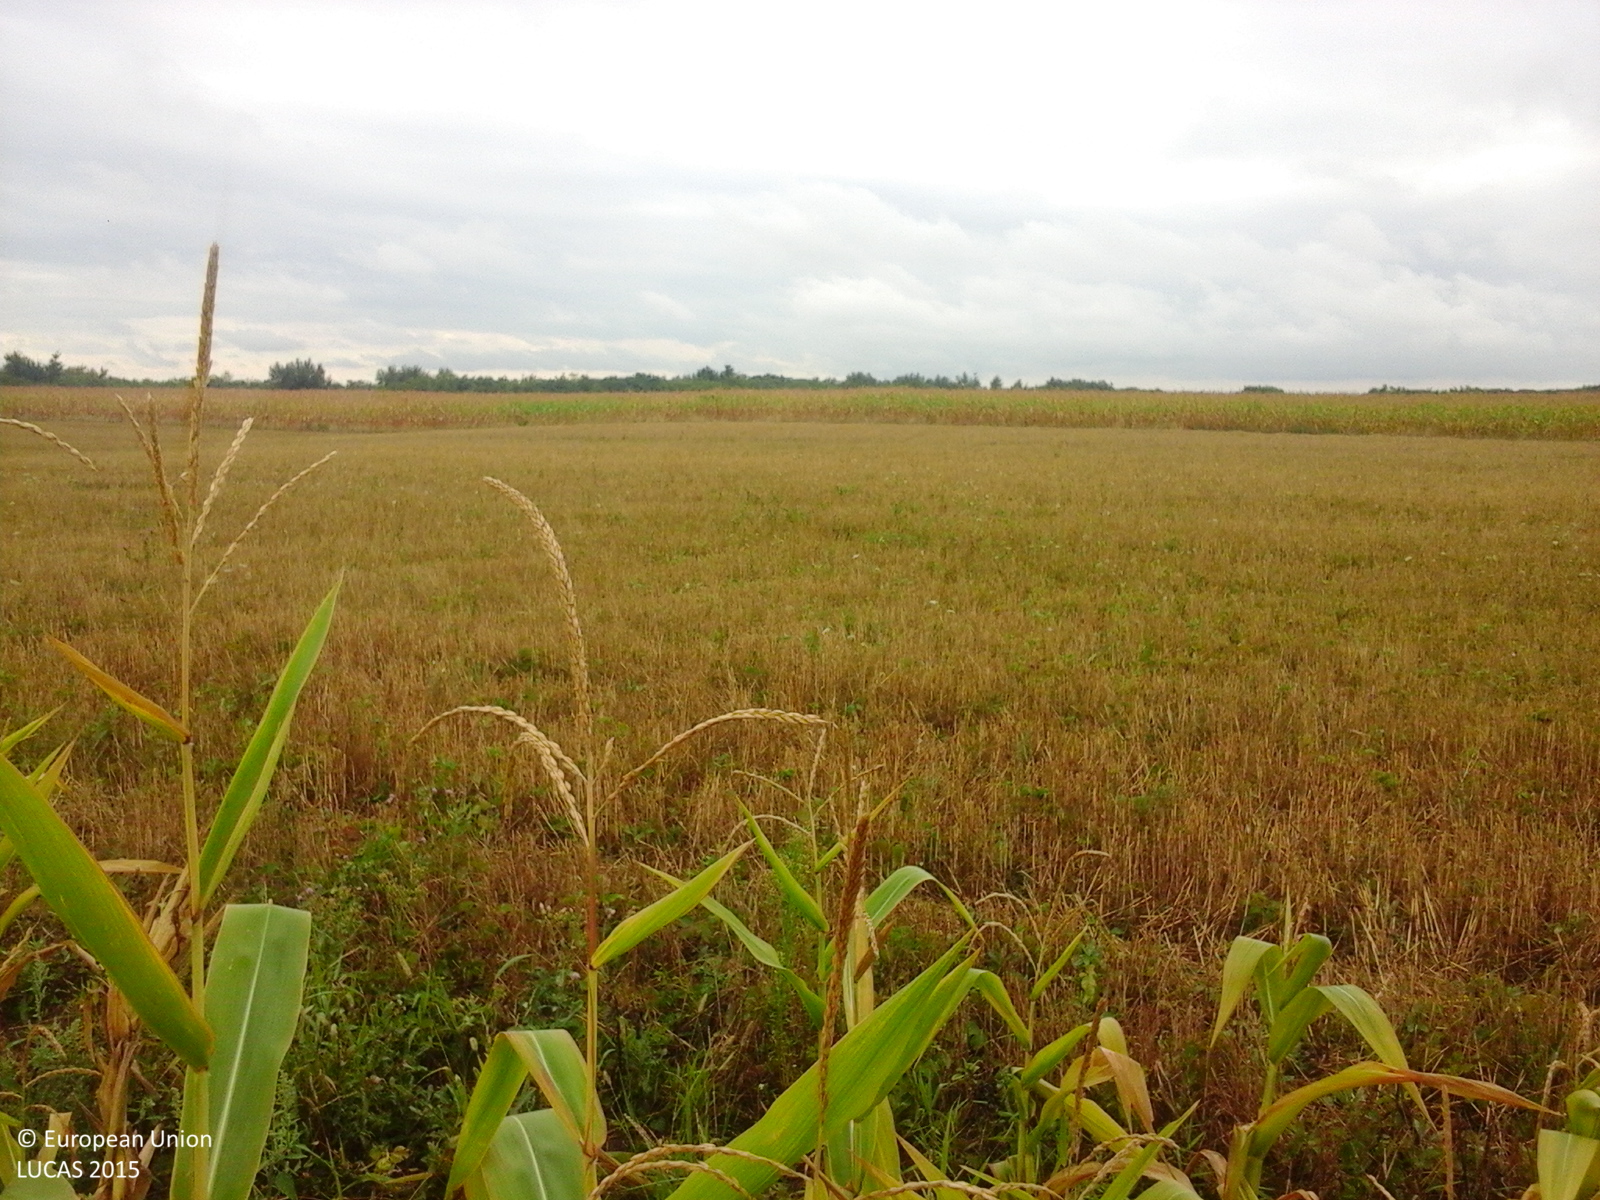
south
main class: Cropland
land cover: Maize
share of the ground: > 75 %
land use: Agriculture (excluding fallow land and kitchen gardens)
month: August
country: RO
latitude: 45.7621
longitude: 21.3595
